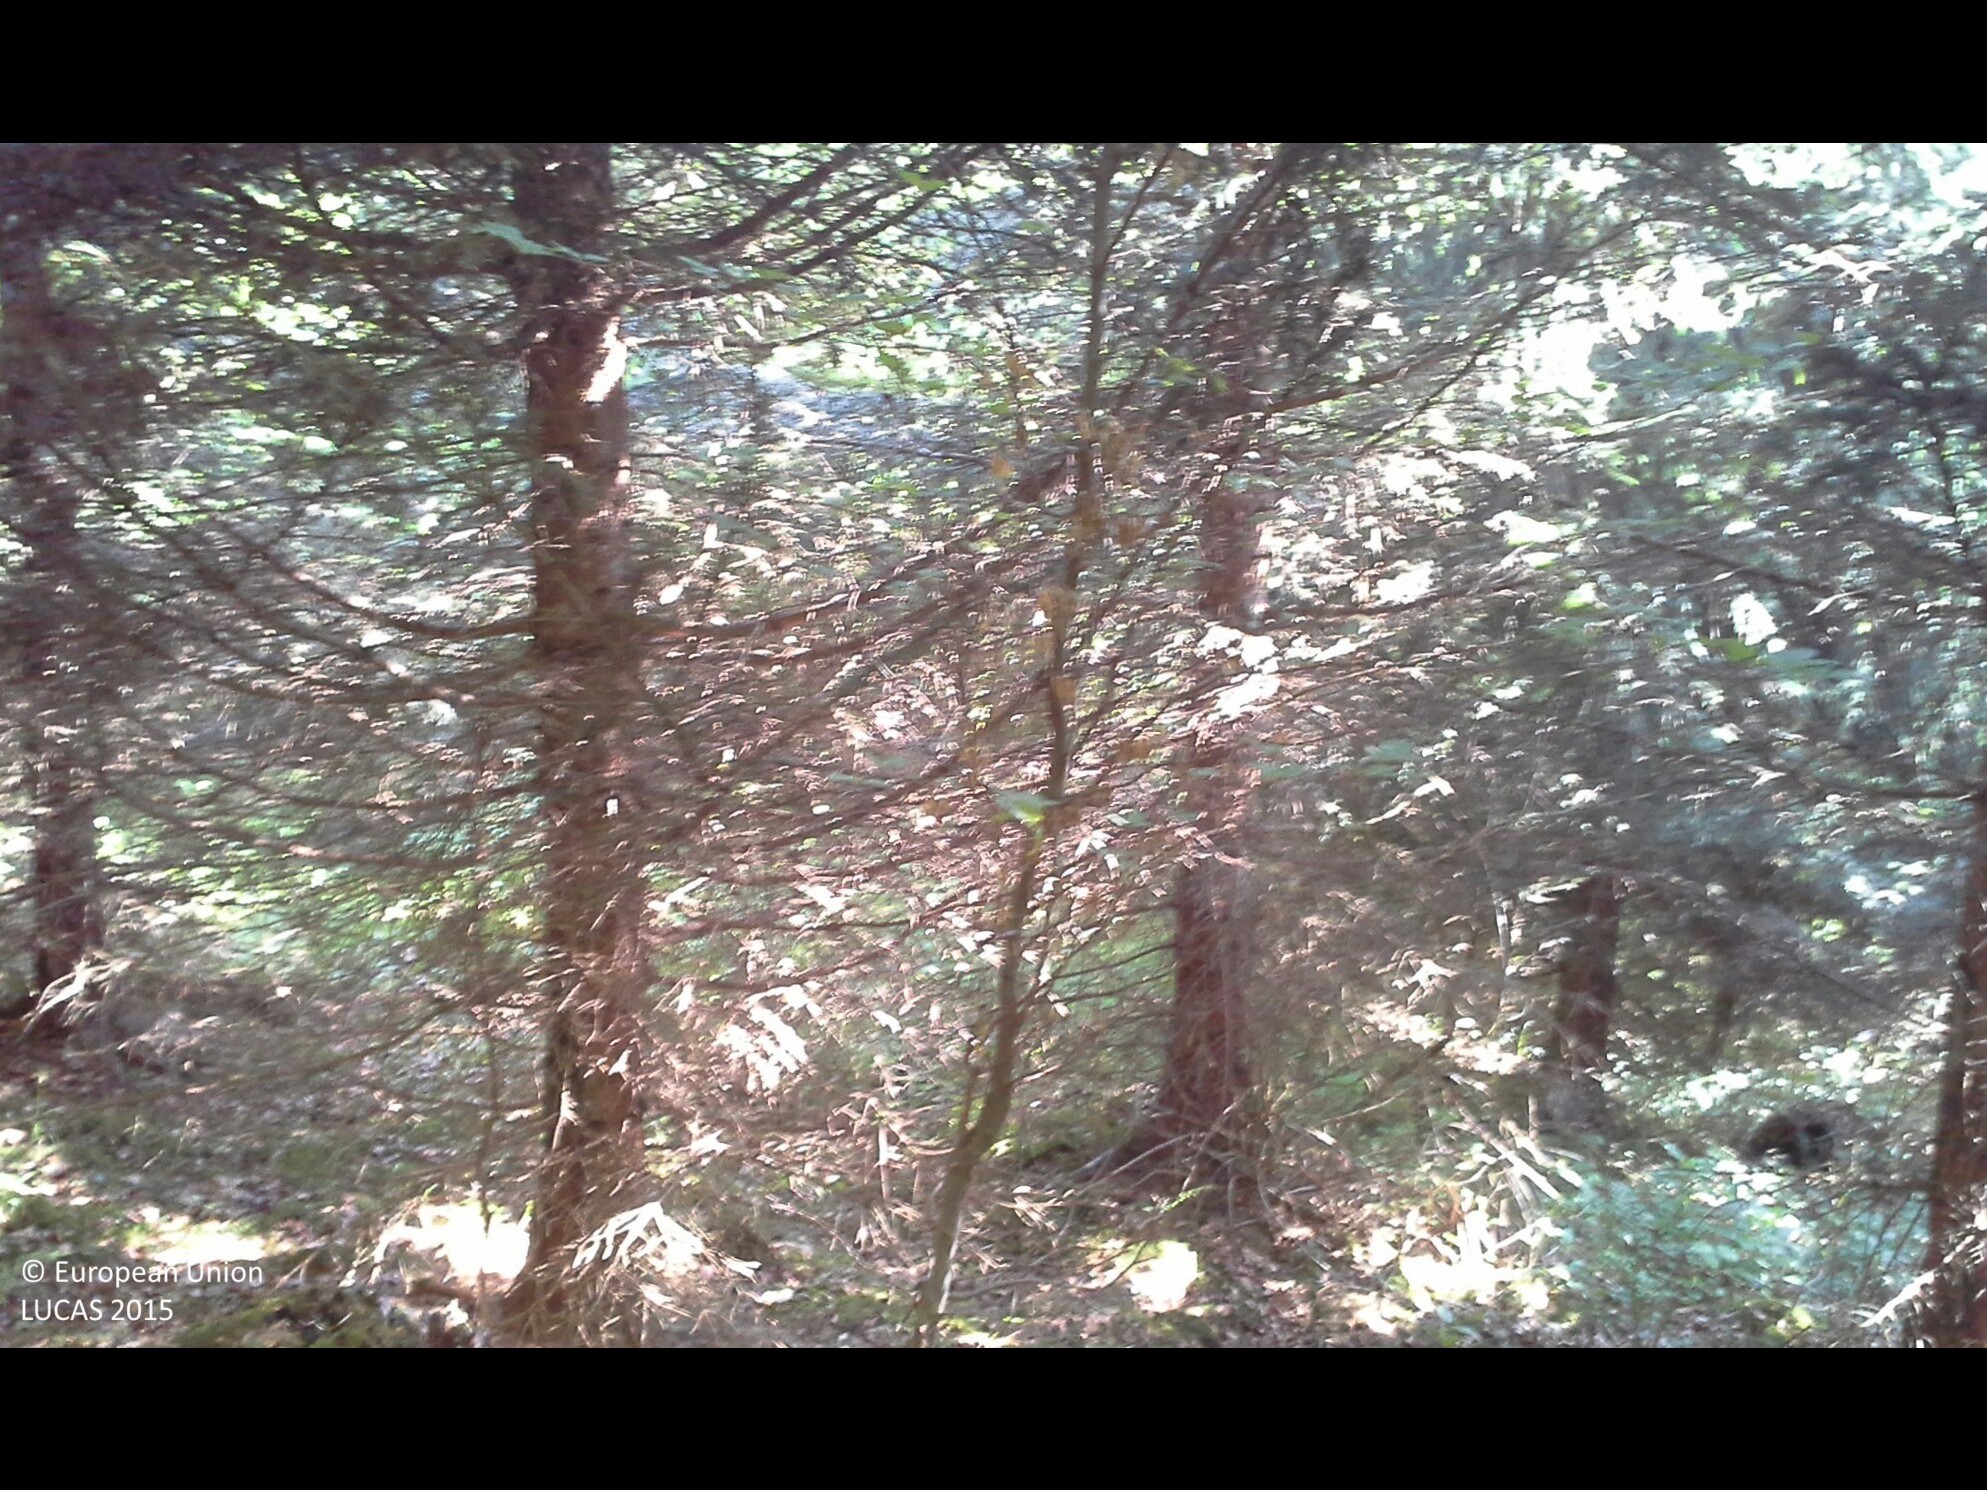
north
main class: Woodland
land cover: Spruce dominated mixed woodland
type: mountainous beech forest
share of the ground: > 75 %
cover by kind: coniferous forest trees 55 %, broadleaved forest trees 35 %, herbaceous plants 10 %
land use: Forestry
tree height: > 5 m
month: June
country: AT
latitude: 47.8443
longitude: 14.4762
